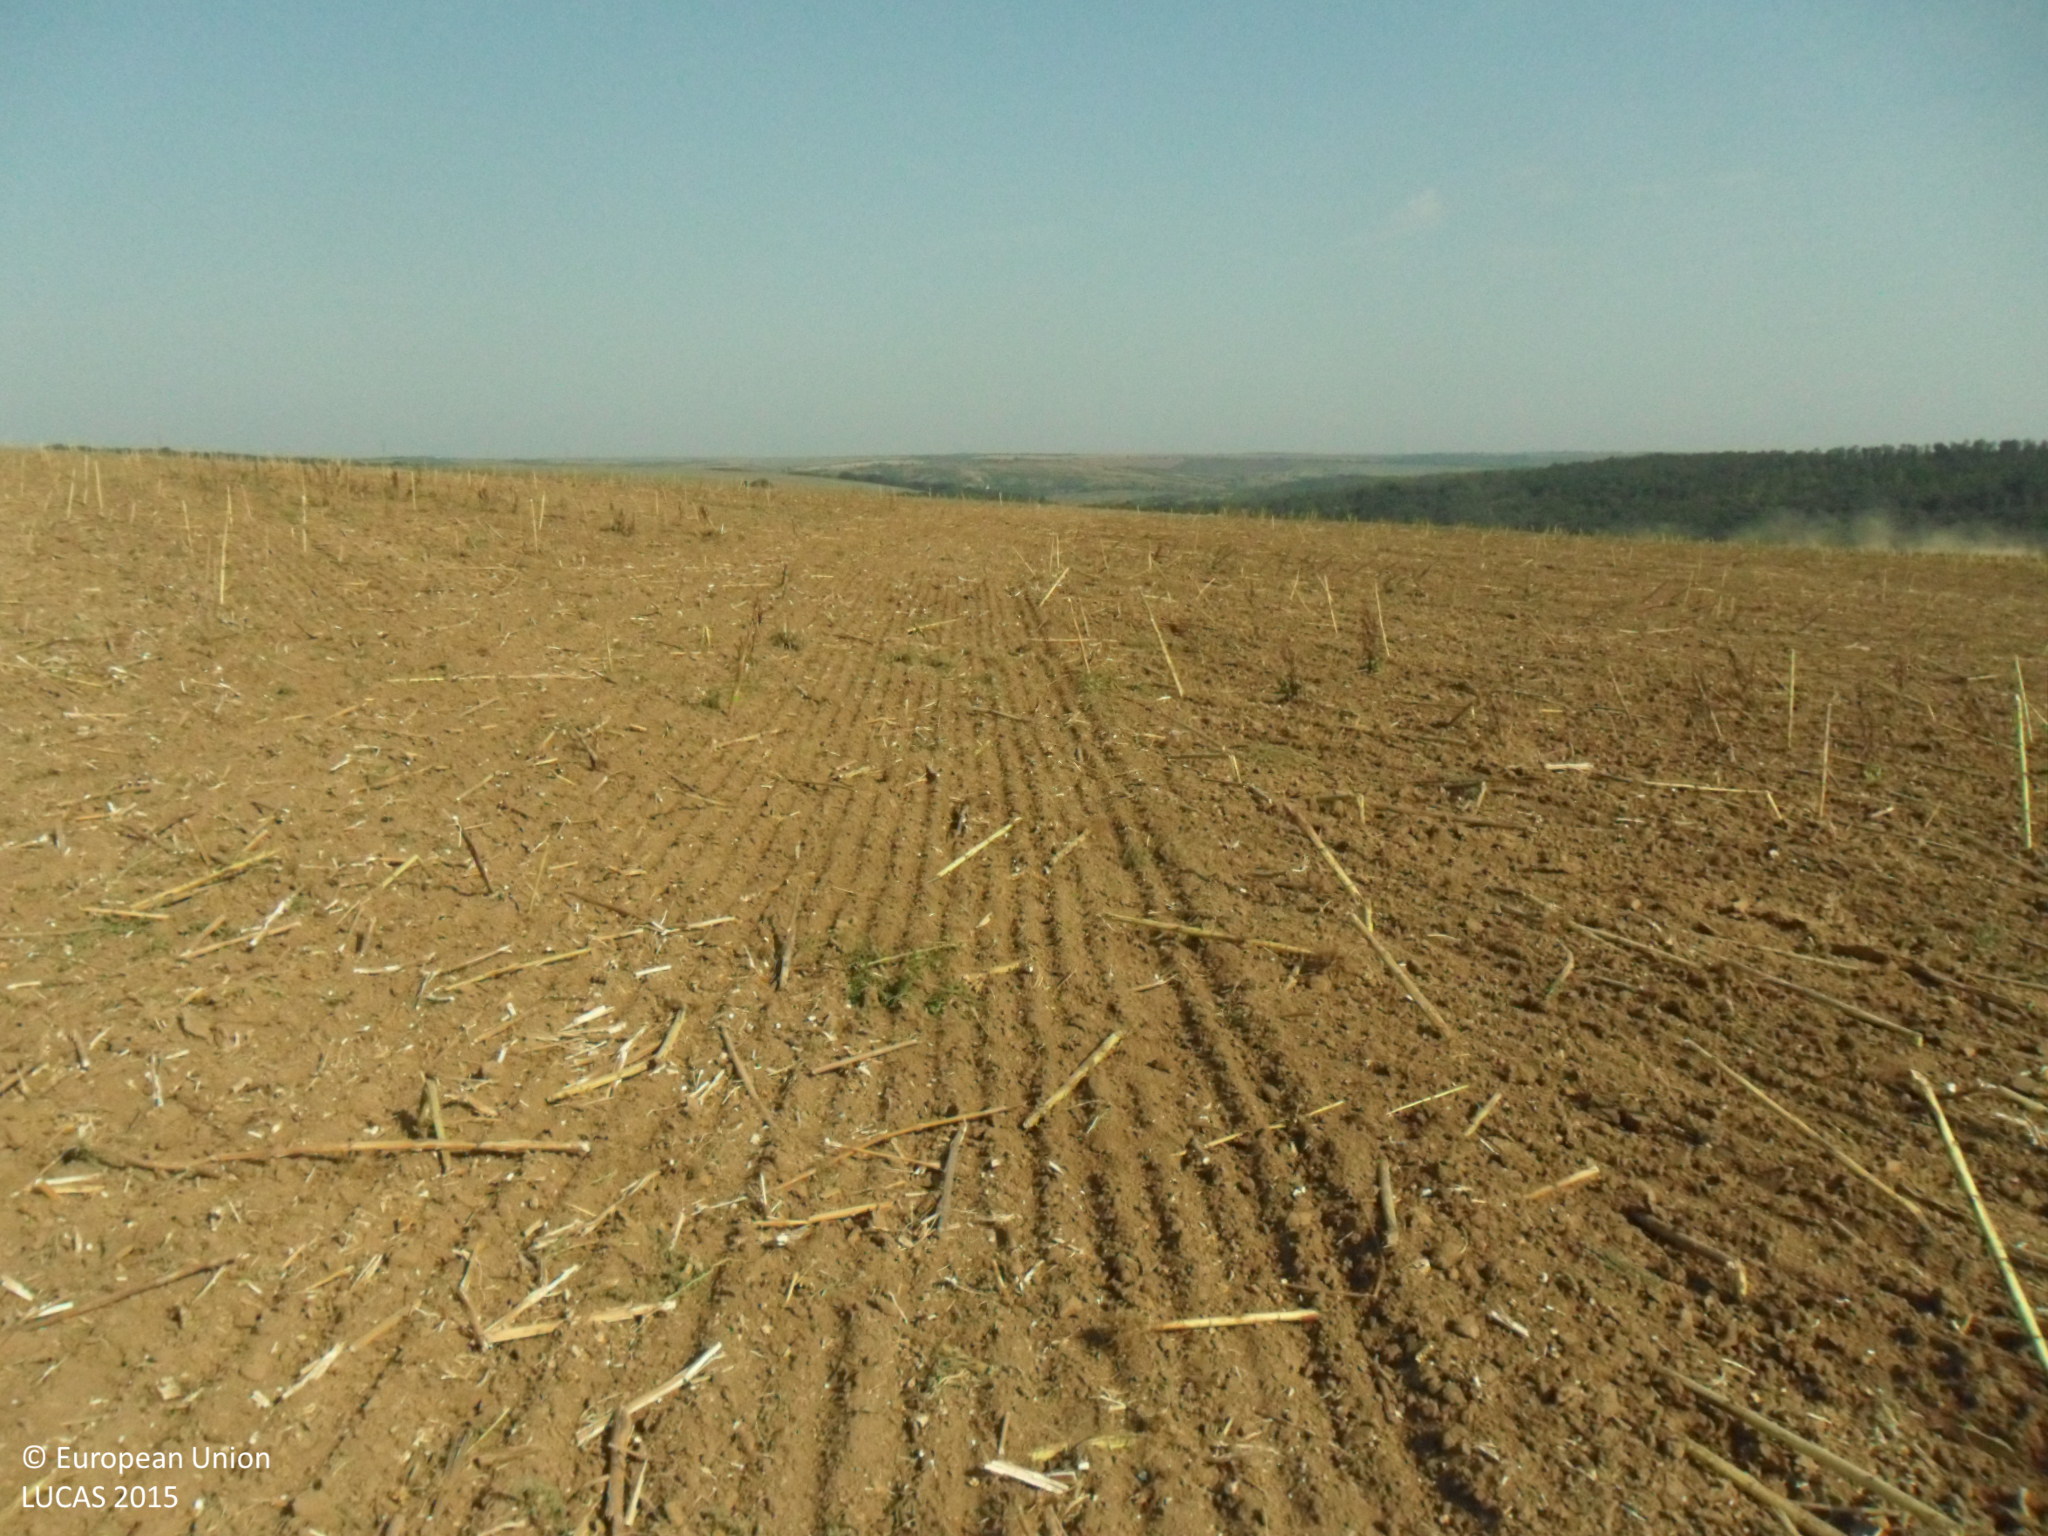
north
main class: Cropland
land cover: Sunflower
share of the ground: < 10 %
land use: Agriculture (excluding fallow land and kitchen gardens)
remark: Harvested field
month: September
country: BG
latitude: 43.6367
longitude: 26.2006
